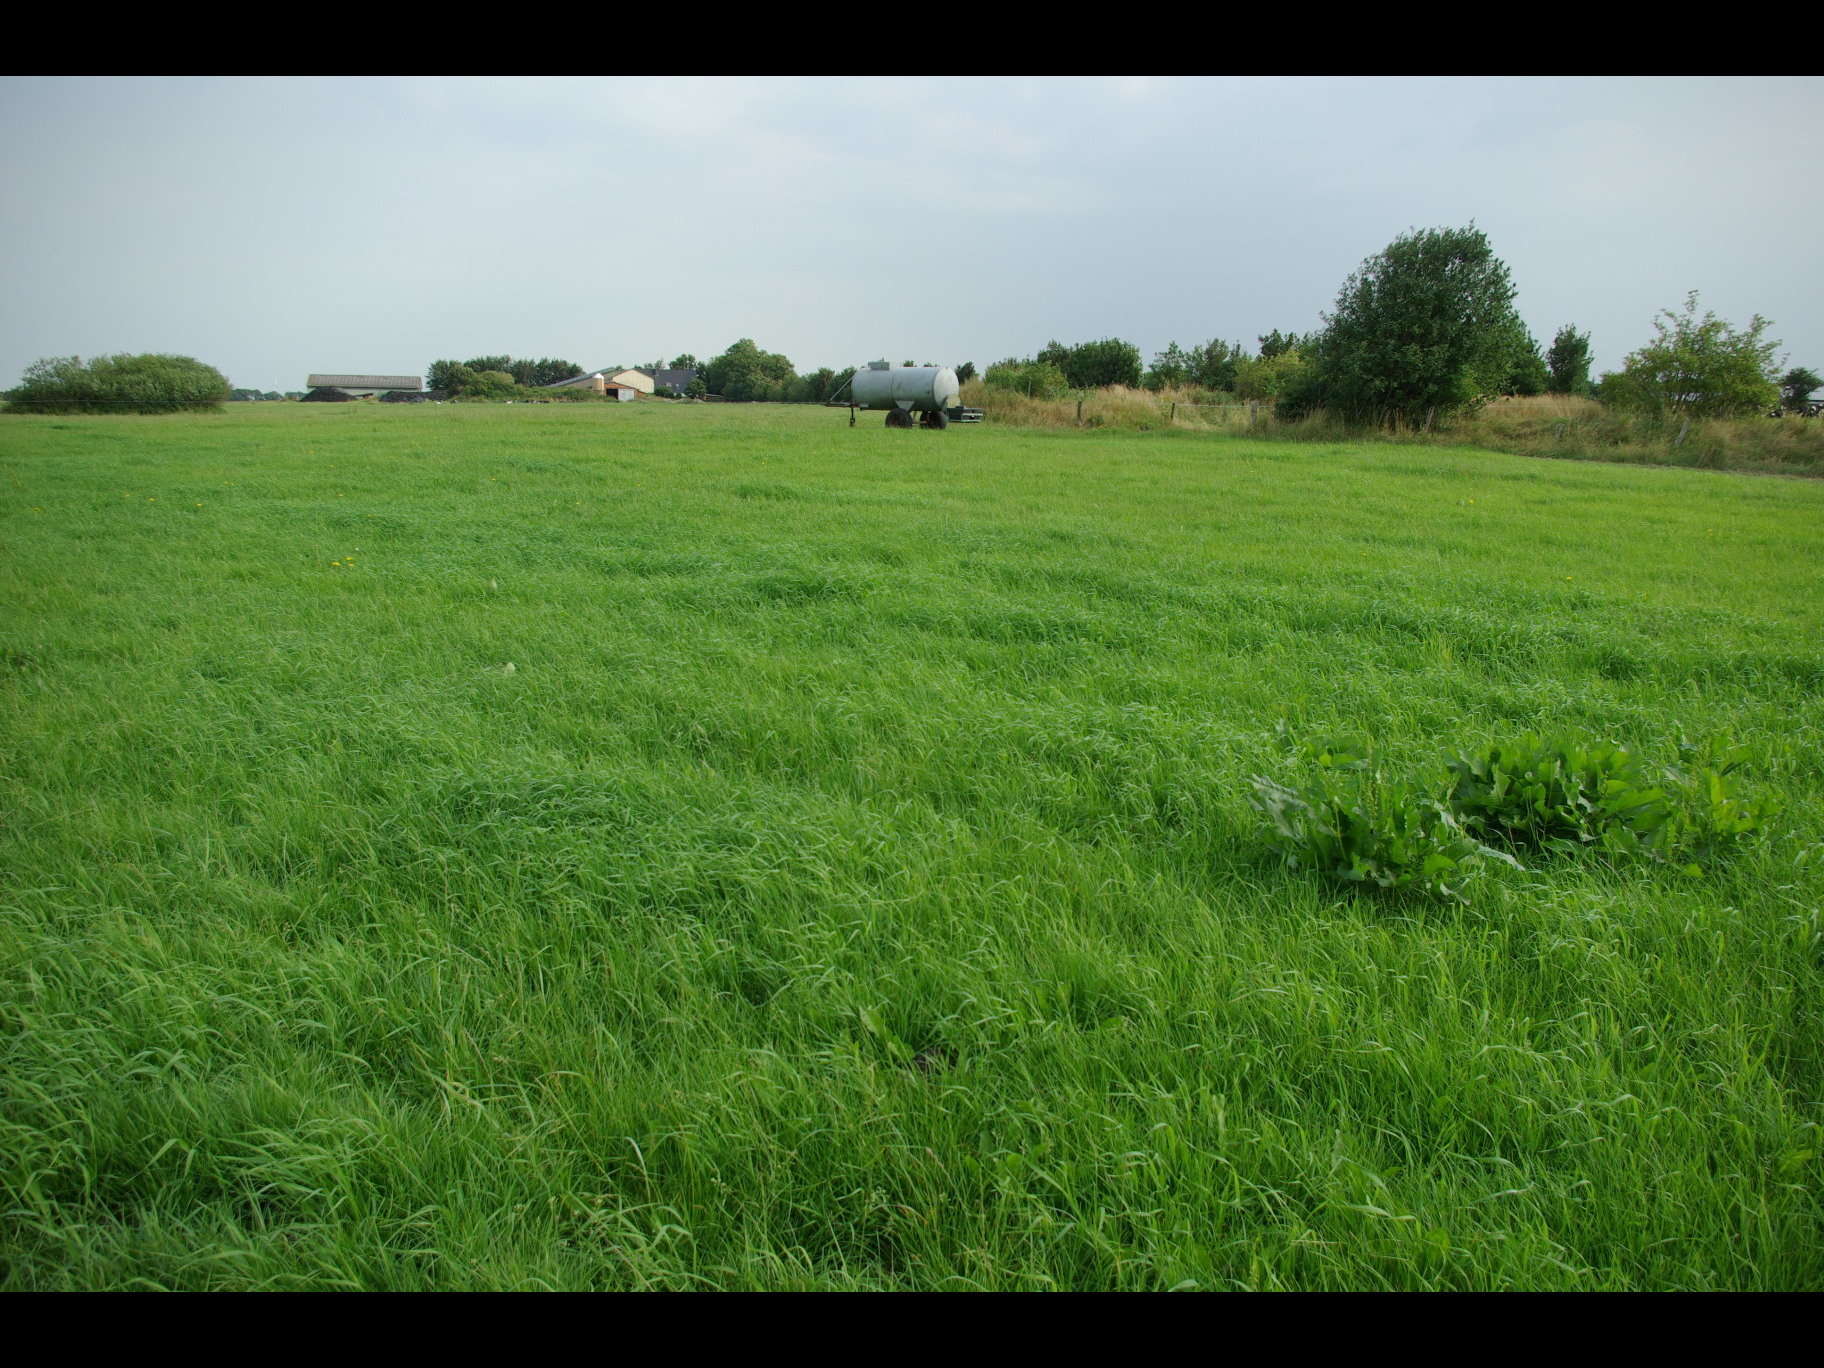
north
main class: Grassland
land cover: Grassland without tree/shrub cover
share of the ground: > 75 %
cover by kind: herbaceous plants 100 %
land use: Agriculture (excluding fallow land and kitchen gardens)
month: August
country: DE
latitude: 54.5315
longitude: 9.1815
